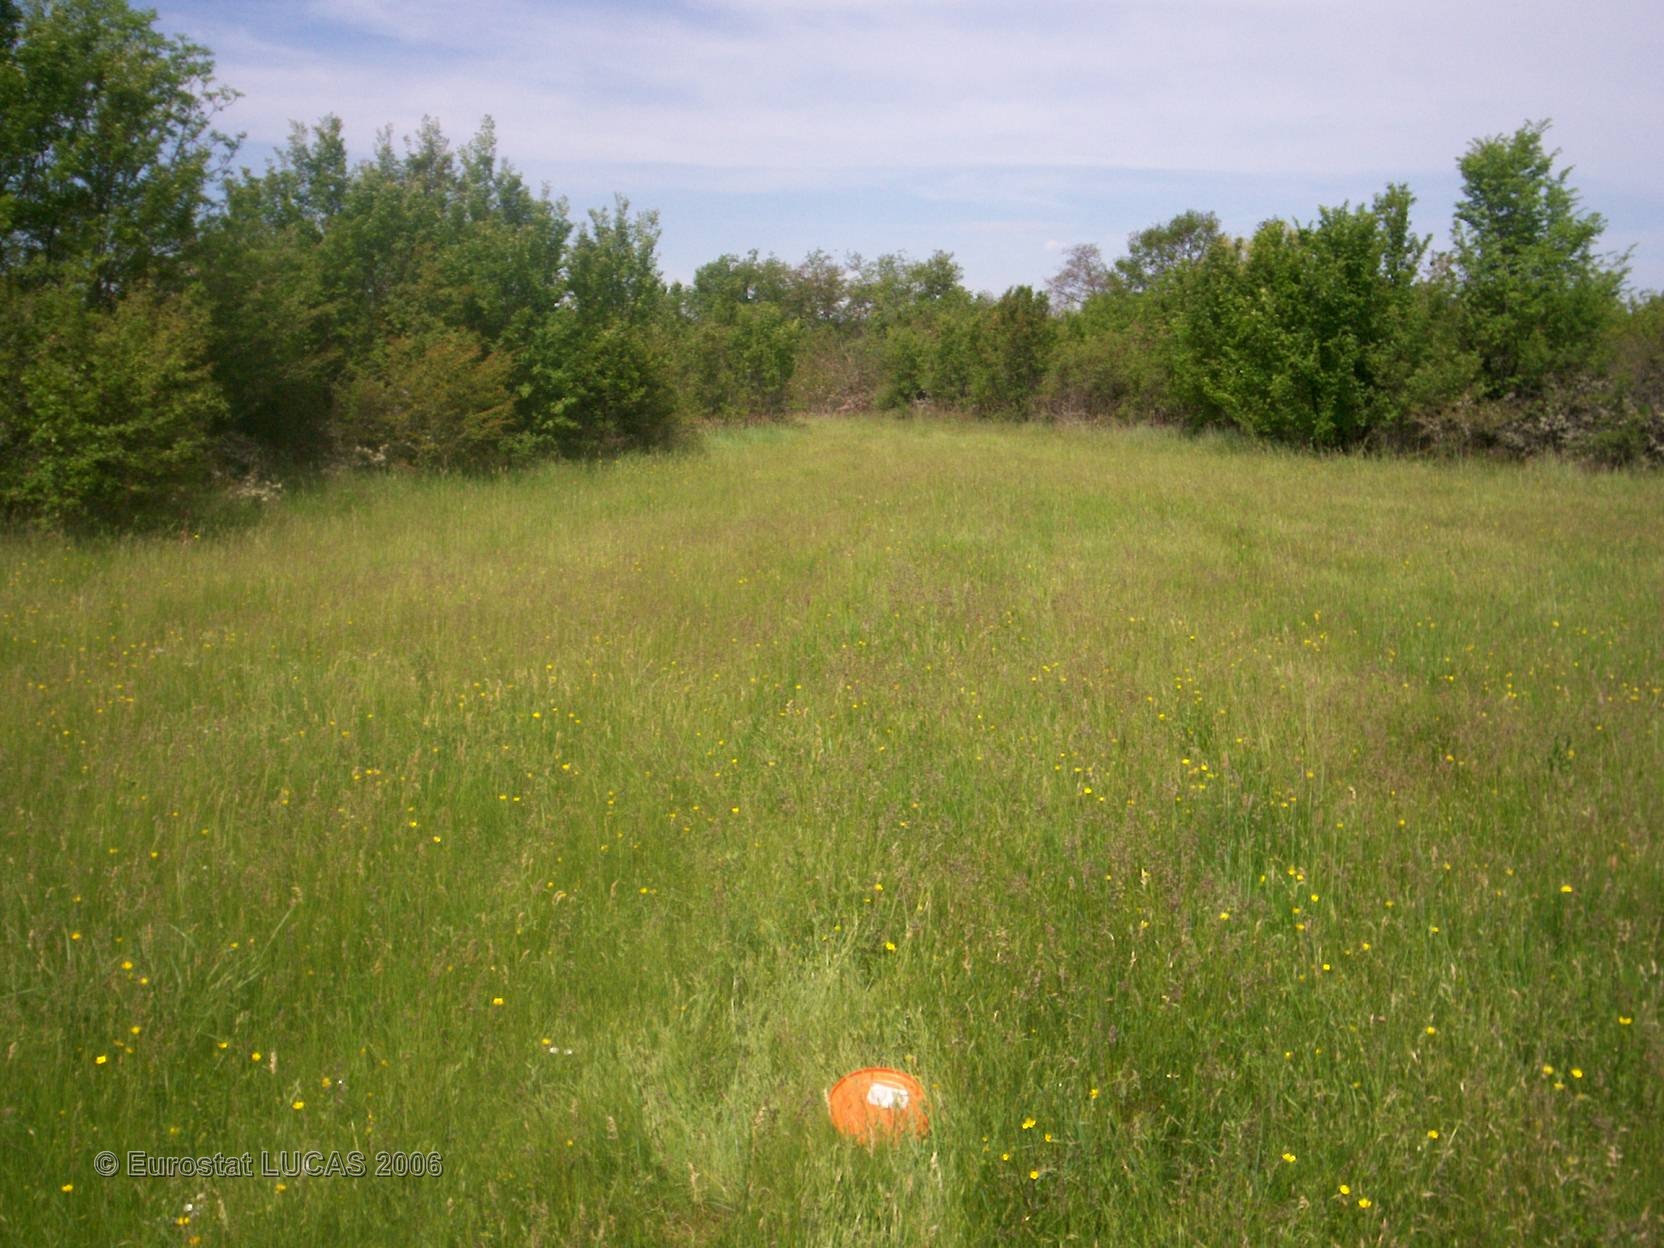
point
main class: Grassland
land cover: Grassland without tree/shrub cover
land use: Agriculture (excluding fallow land and kitchen gardens)
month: May
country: FR
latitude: 45.5040
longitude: 3.2306
